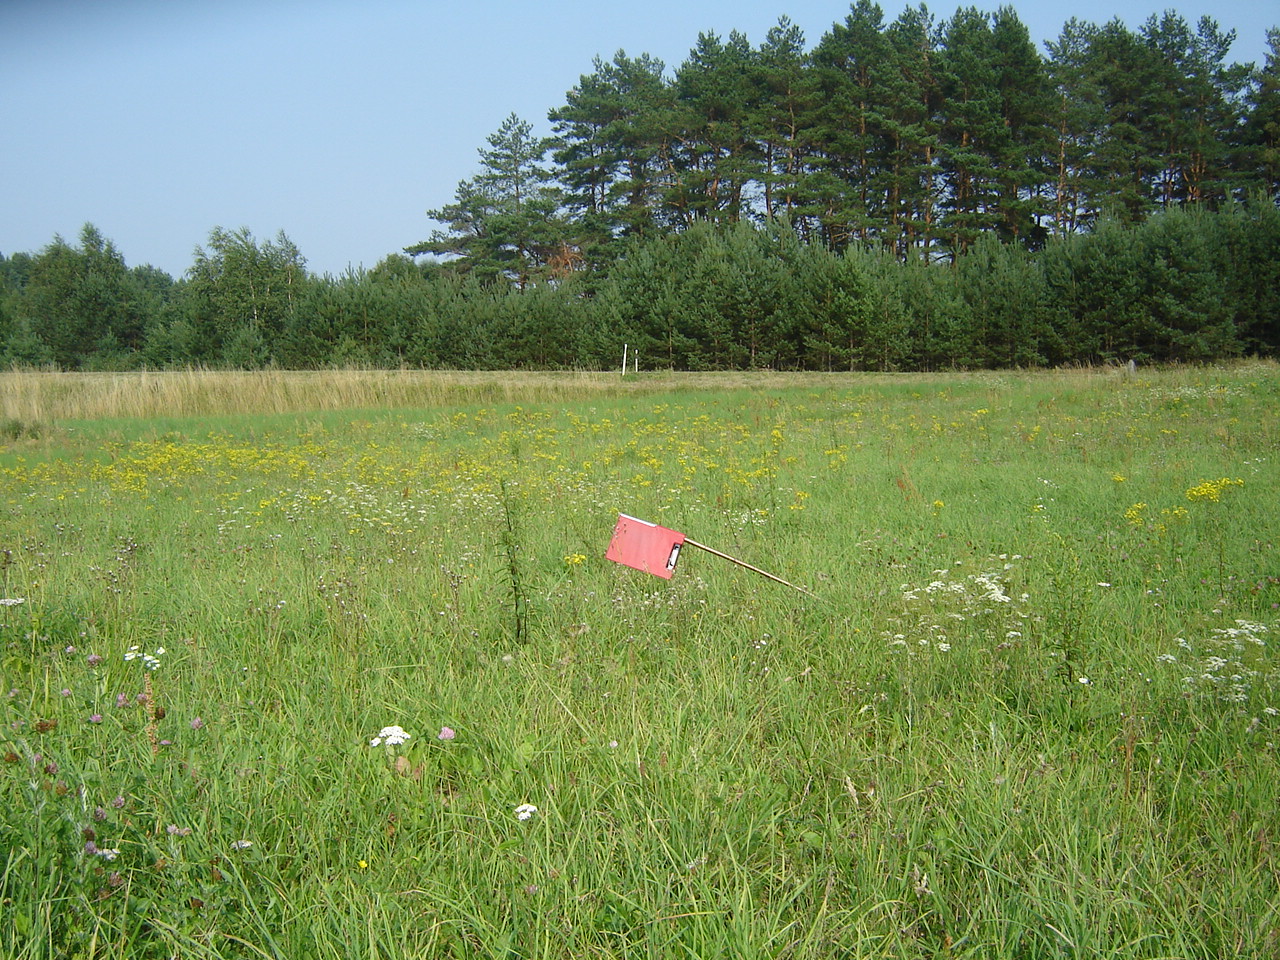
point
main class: Grassland
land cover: Grassland without tree/shrub cover
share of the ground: > 75 %
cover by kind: herbaceous plants 100 %
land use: Agriculture (excluding fallow land and kitchen gardens)
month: August
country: LT
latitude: 54.8960
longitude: 24.8451
